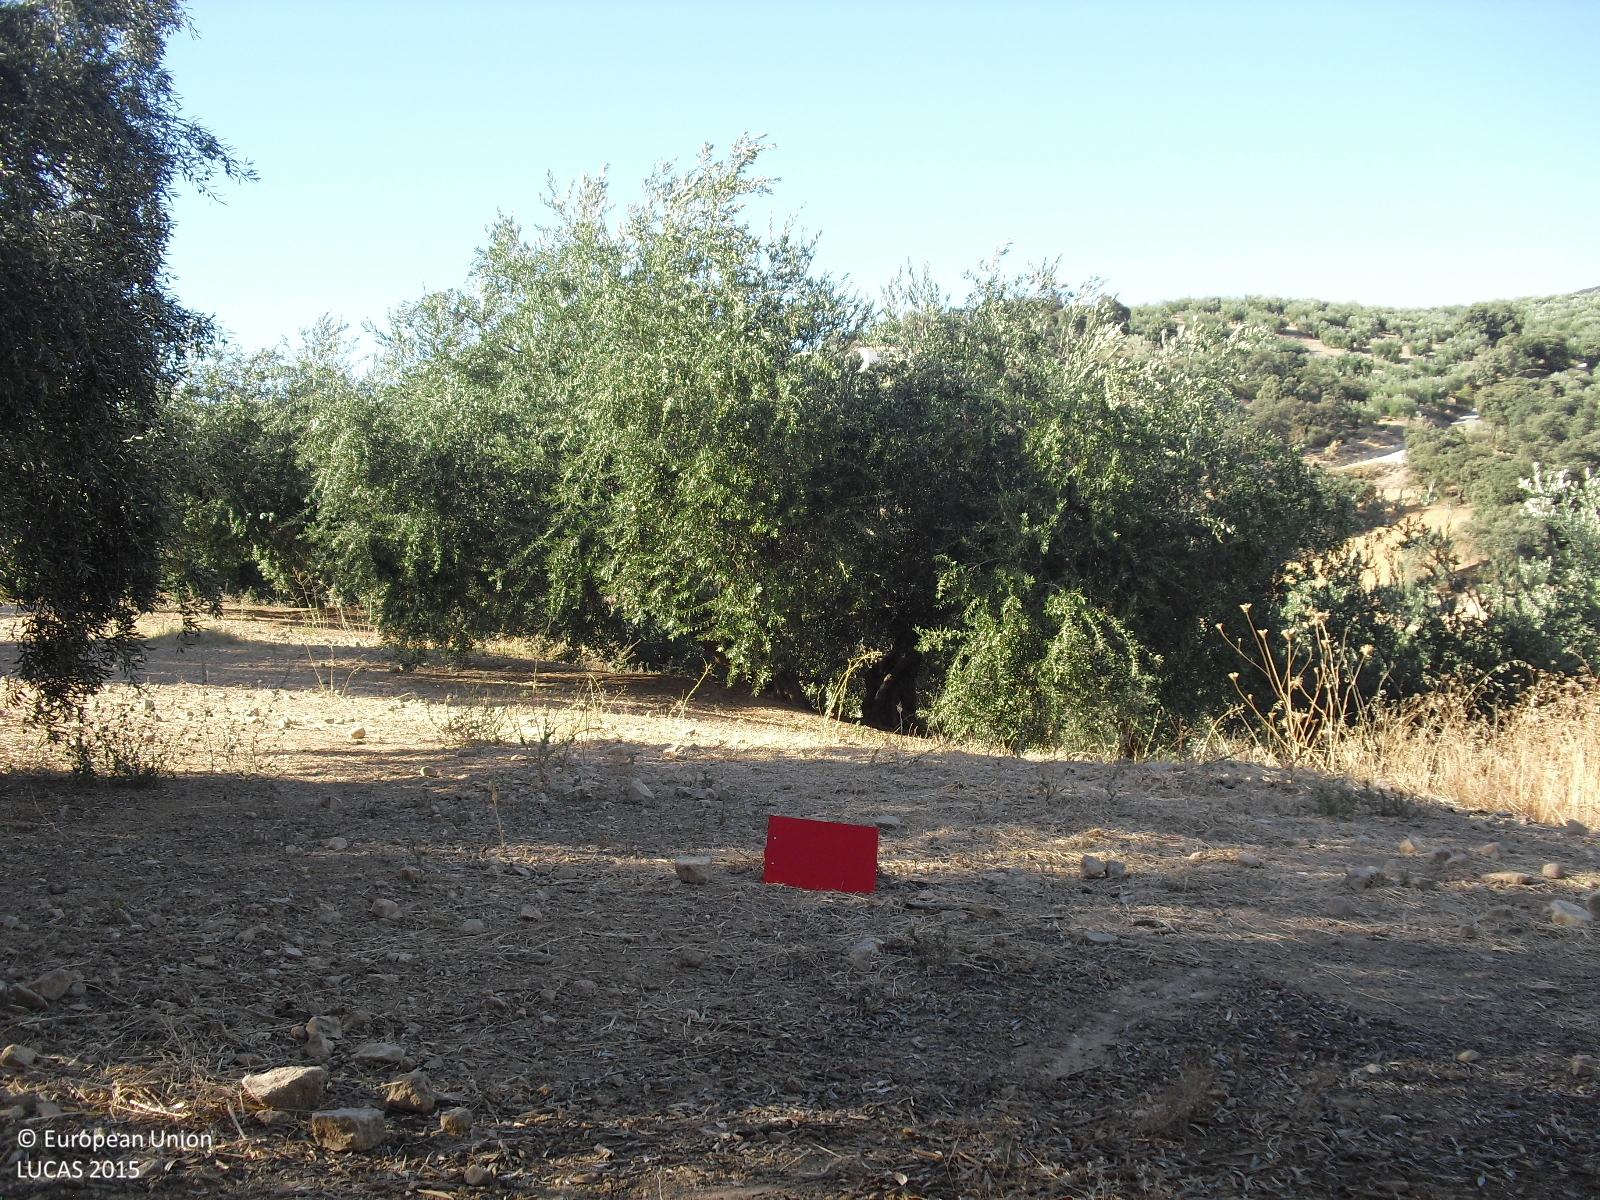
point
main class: Cropland
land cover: Olive groves
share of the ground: 25 - 50 %
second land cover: Other bare soil
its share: > 75 %
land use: Agriculture (excluding fallow land and kitchen gardens)
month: August
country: ES
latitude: 37.2897
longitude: -4.1531
